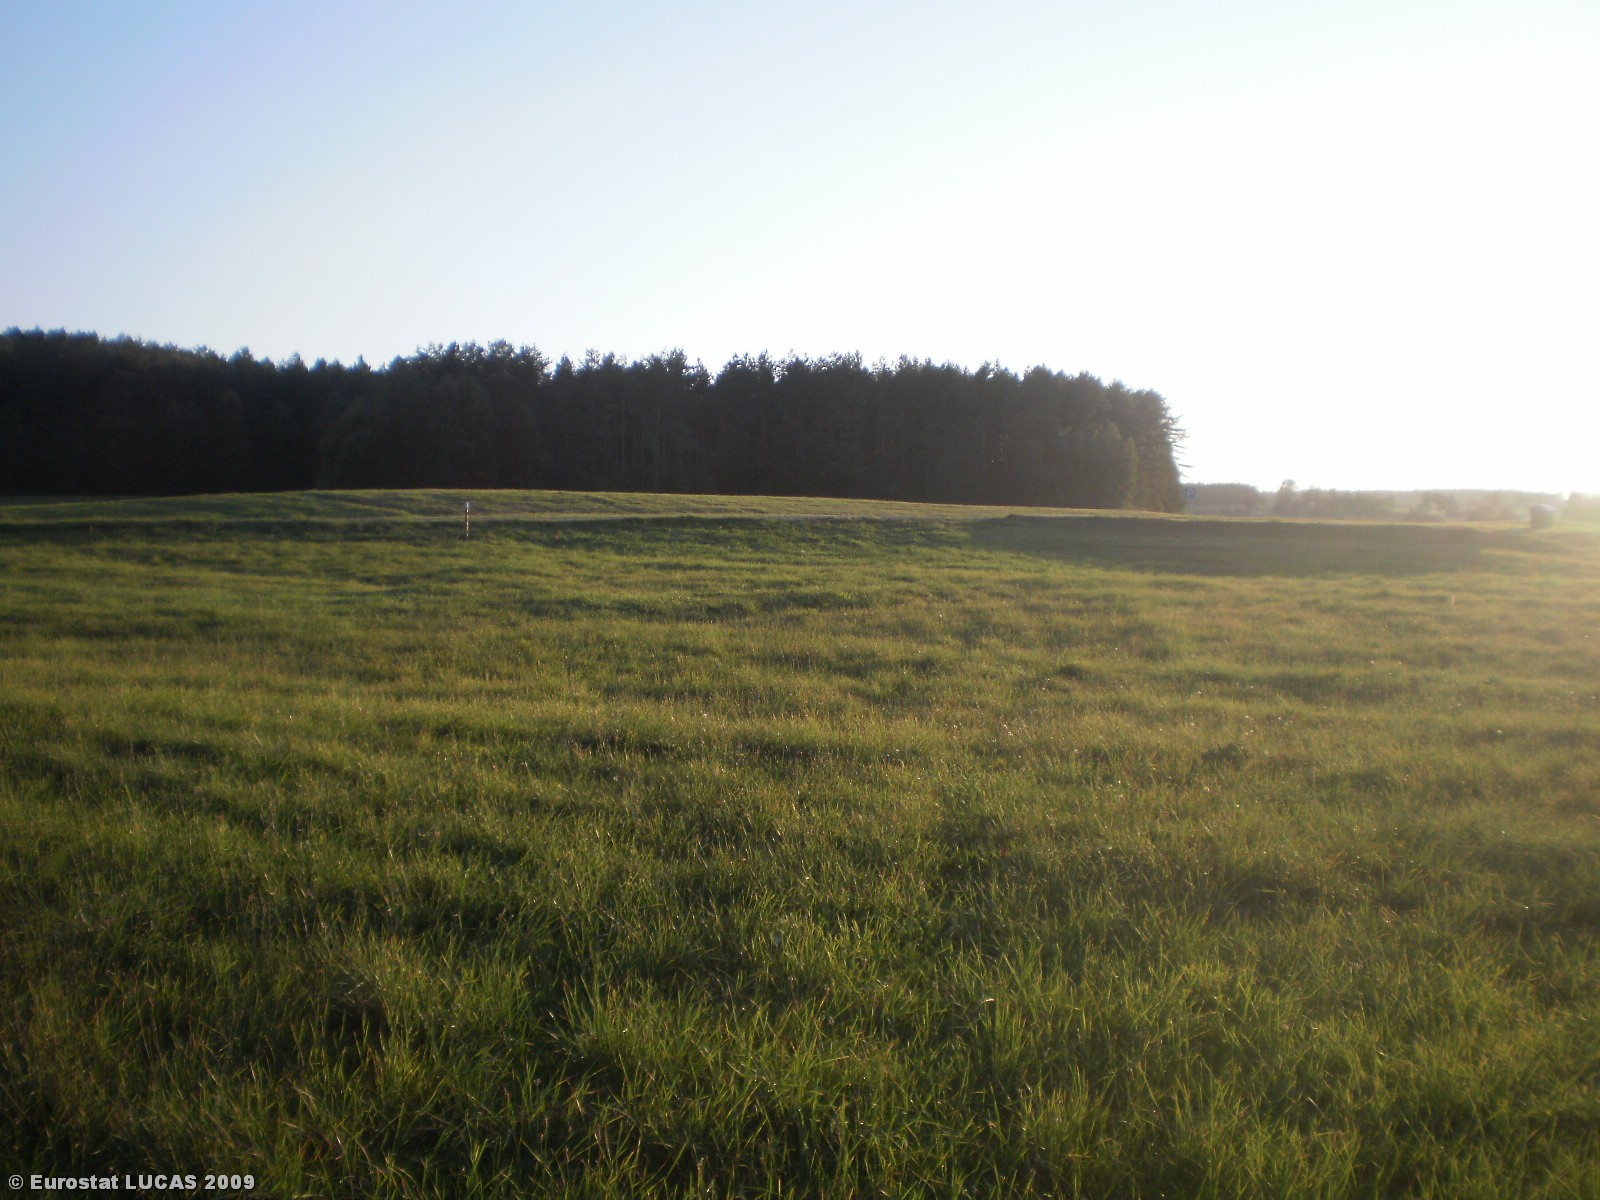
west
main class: Grassland
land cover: Grassland without tree/shrub cover
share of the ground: > 75 %
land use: Agriculture (excluding fallow land and kitchen gardens)
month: August
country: LT
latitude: 54.8375
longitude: 24.5683
